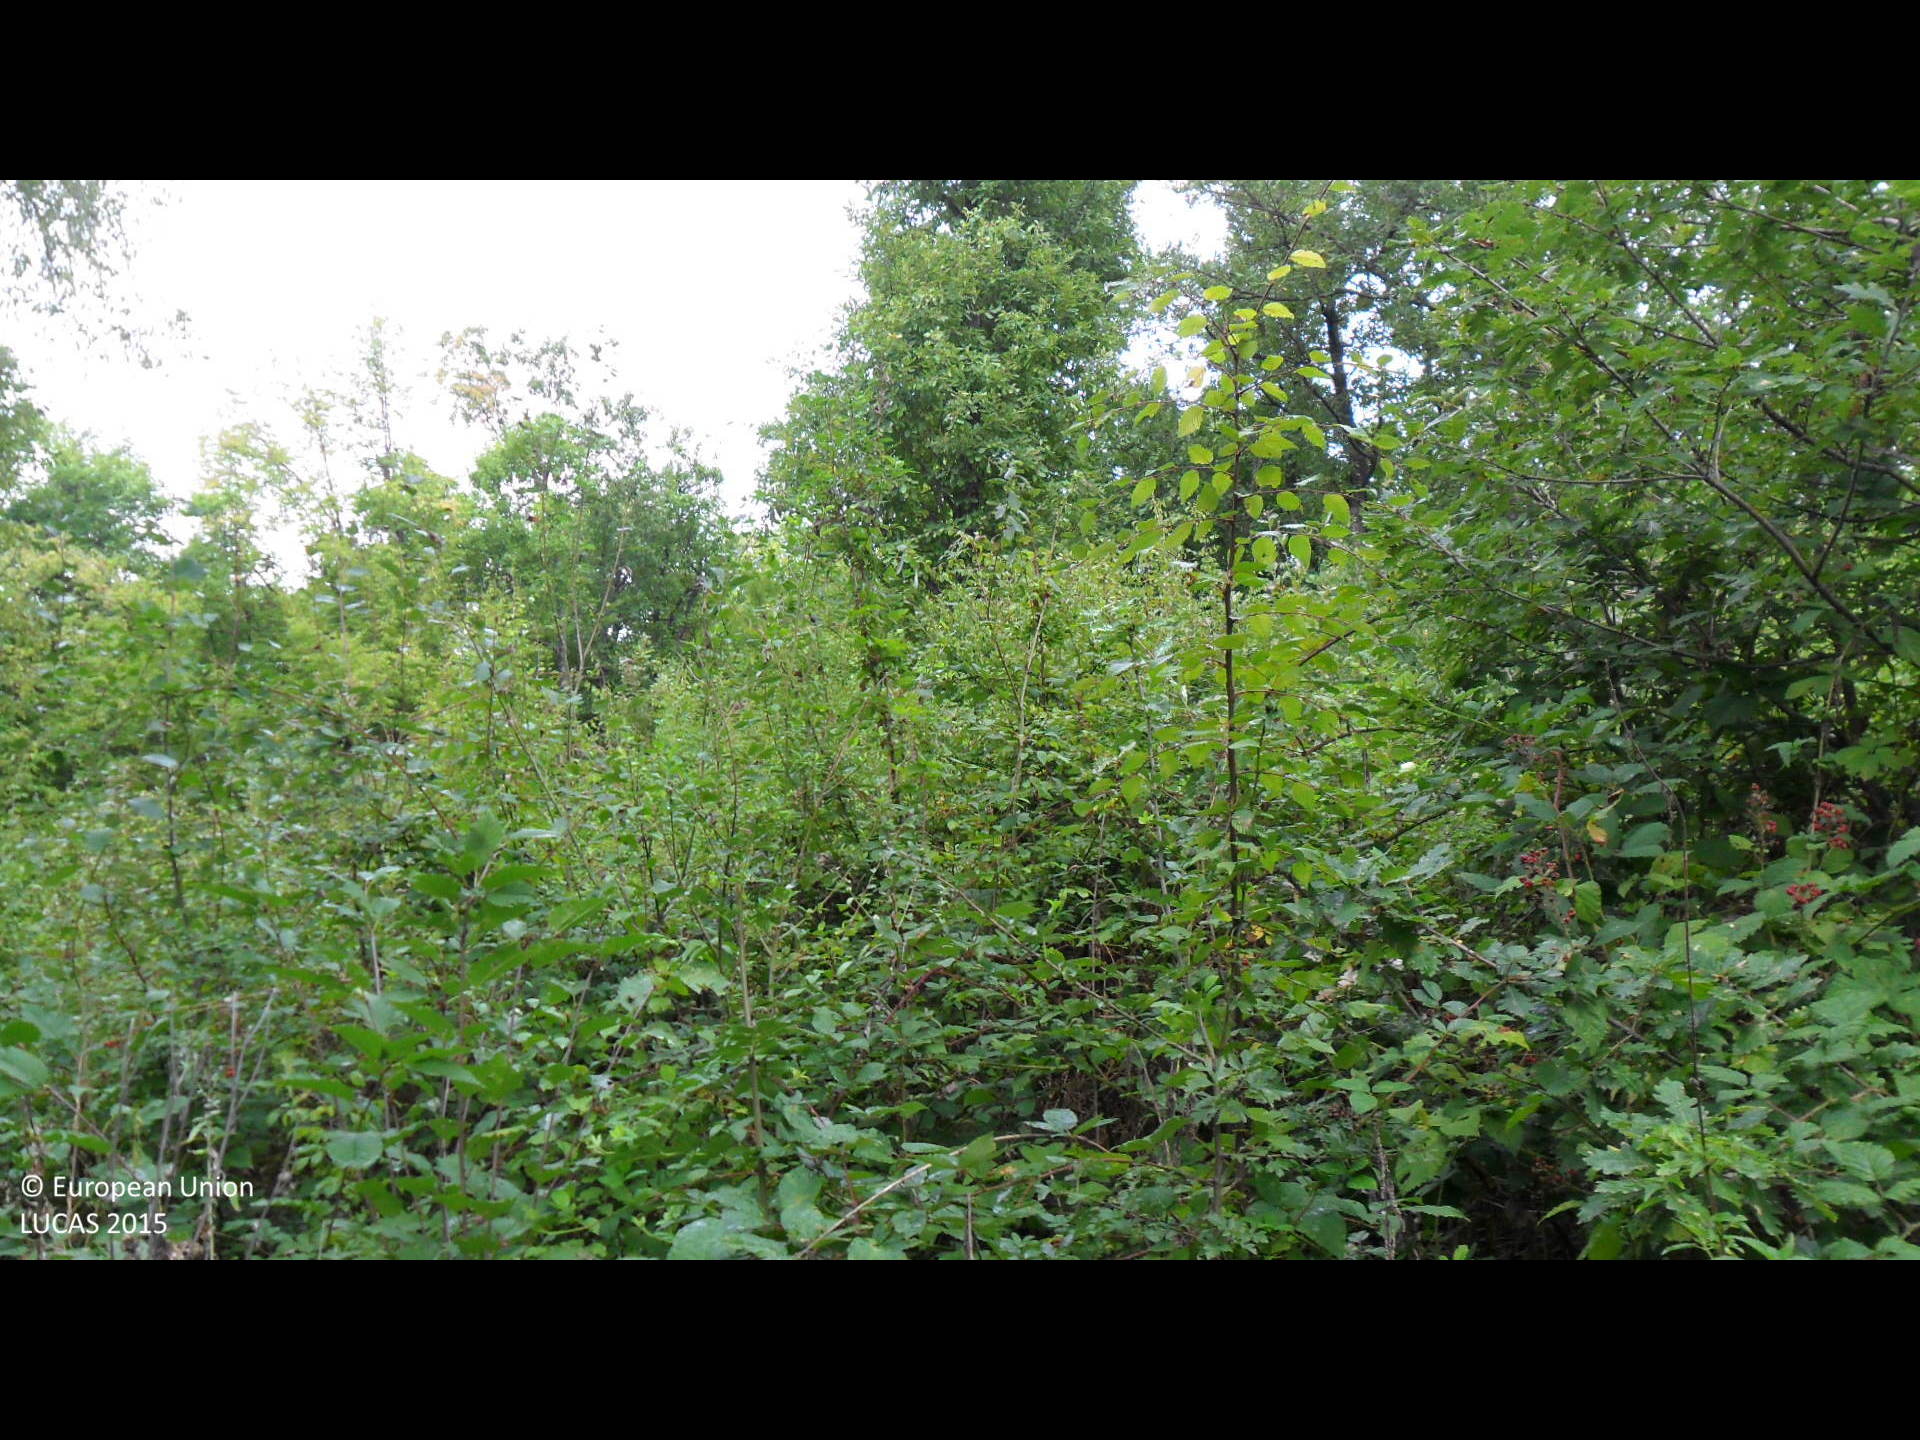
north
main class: Woodland
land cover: Broadleaved woodland
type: thermophilous deciduous forest
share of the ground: > 75 %
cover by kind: broadleaved forest trees 90 %, unconsolidated bare surface 10 %
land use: Forestry
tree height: > 5 m
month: September
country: BG
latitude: 43.0375
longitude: 26.3842
